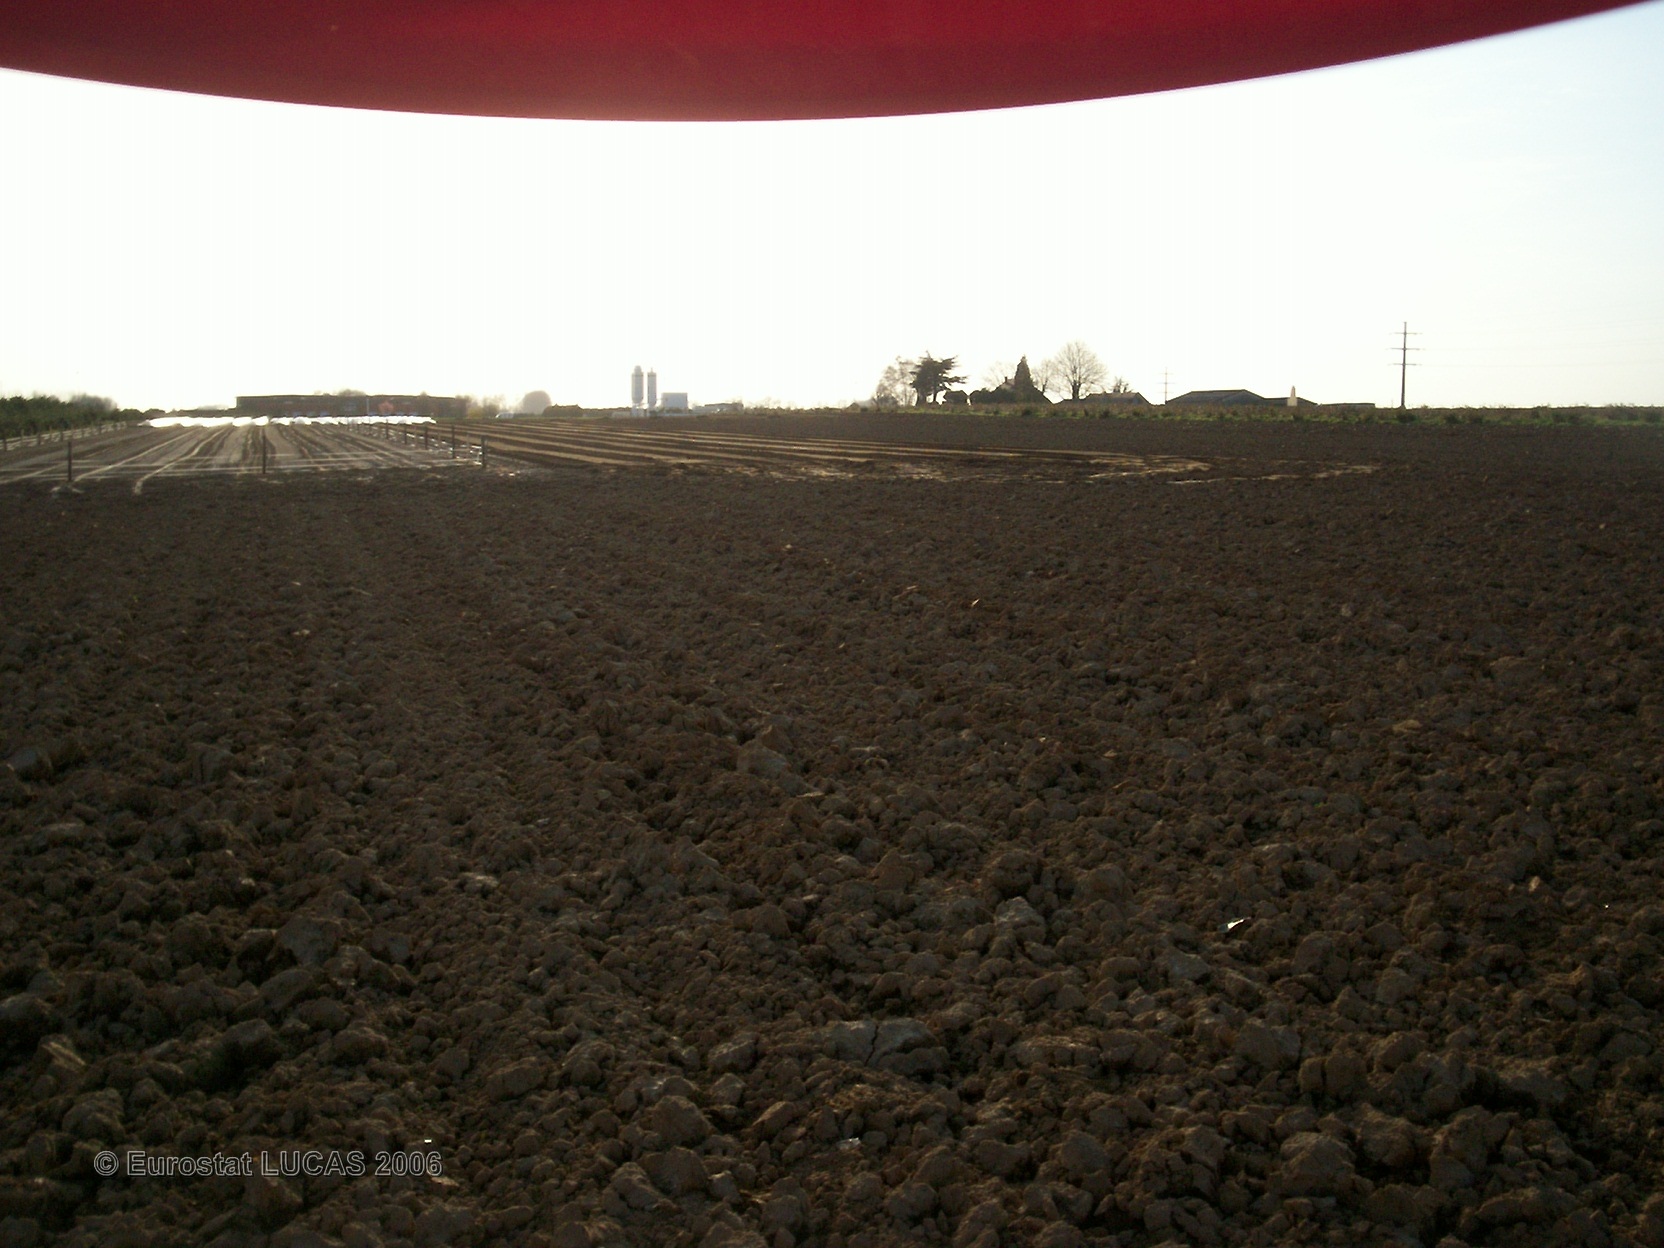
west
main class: Cropland
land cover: Maize
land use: Agriculture (excluding fallow land and kitchen gardens)
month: April
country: FR
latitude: 49.6749
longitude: 0.8999
